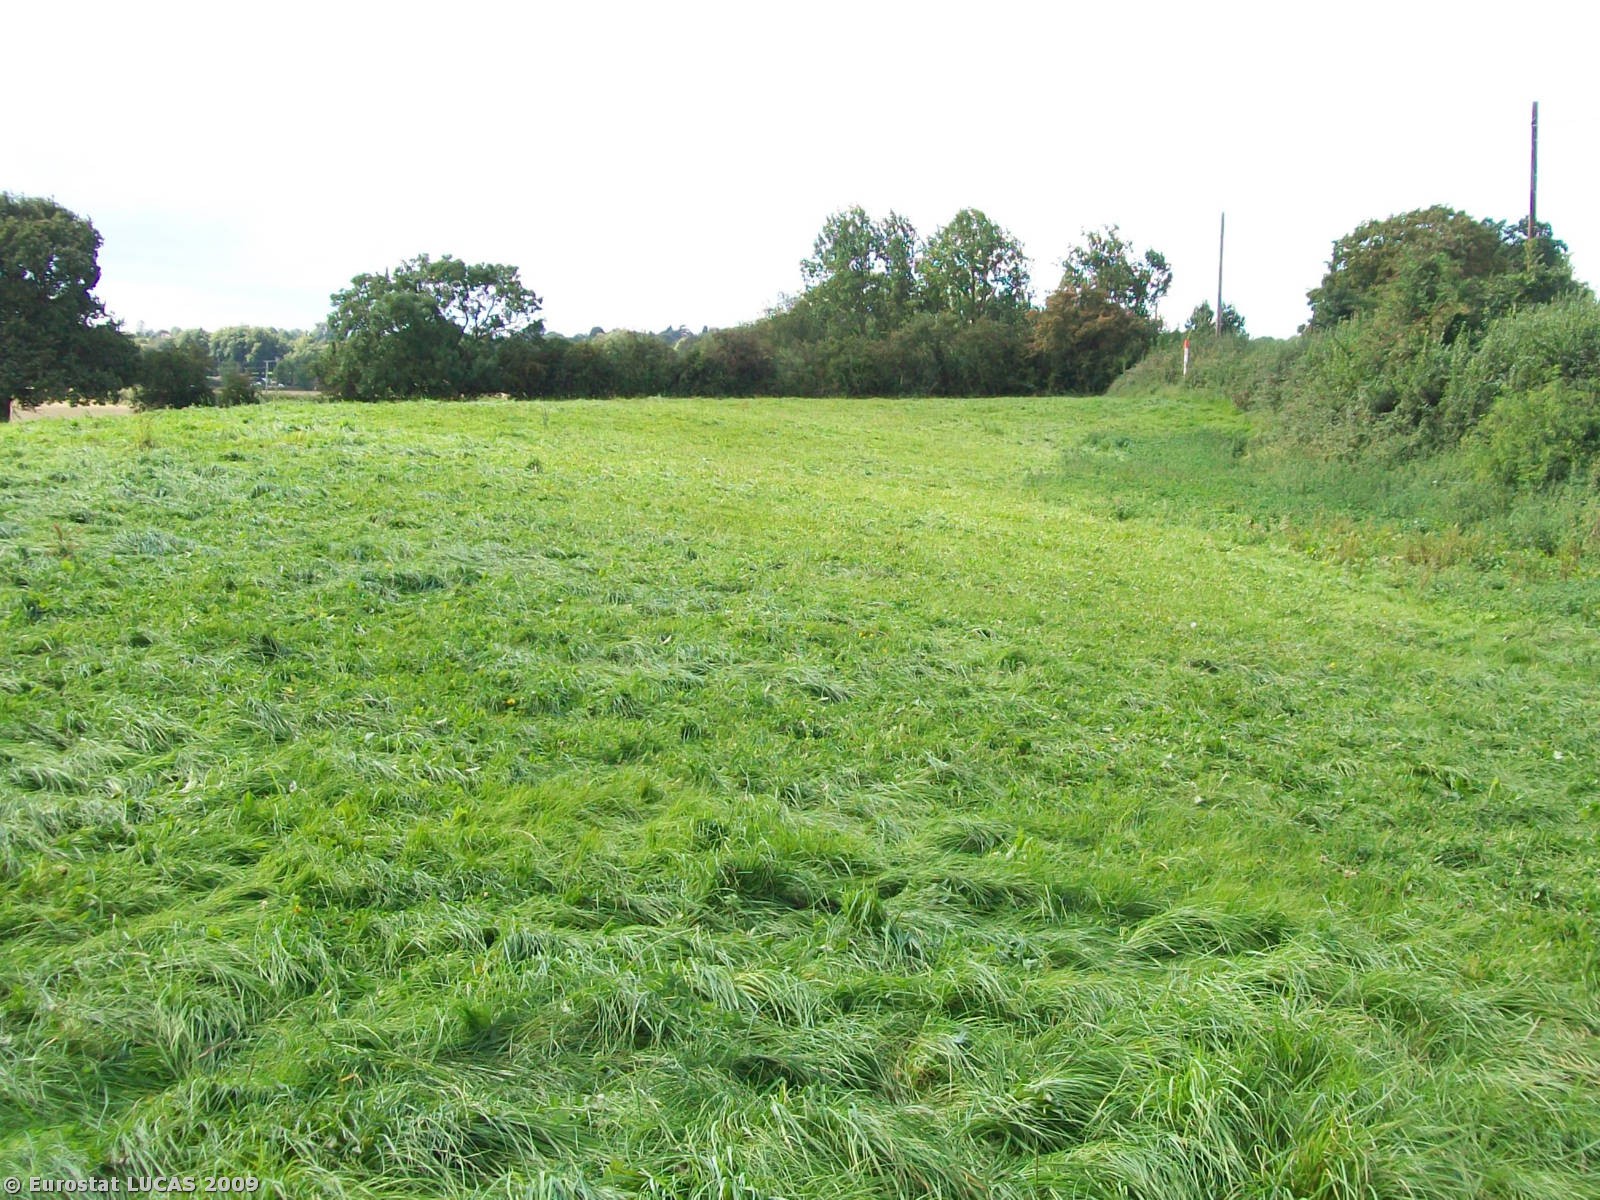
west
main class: Grassland
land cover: Grassland without tree/shrub cover
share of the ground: > 75 %
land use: Agriculture (excluding fallow land and kitchen gardens)
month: August
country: GB
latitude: 51.9854
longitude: -2.3388
